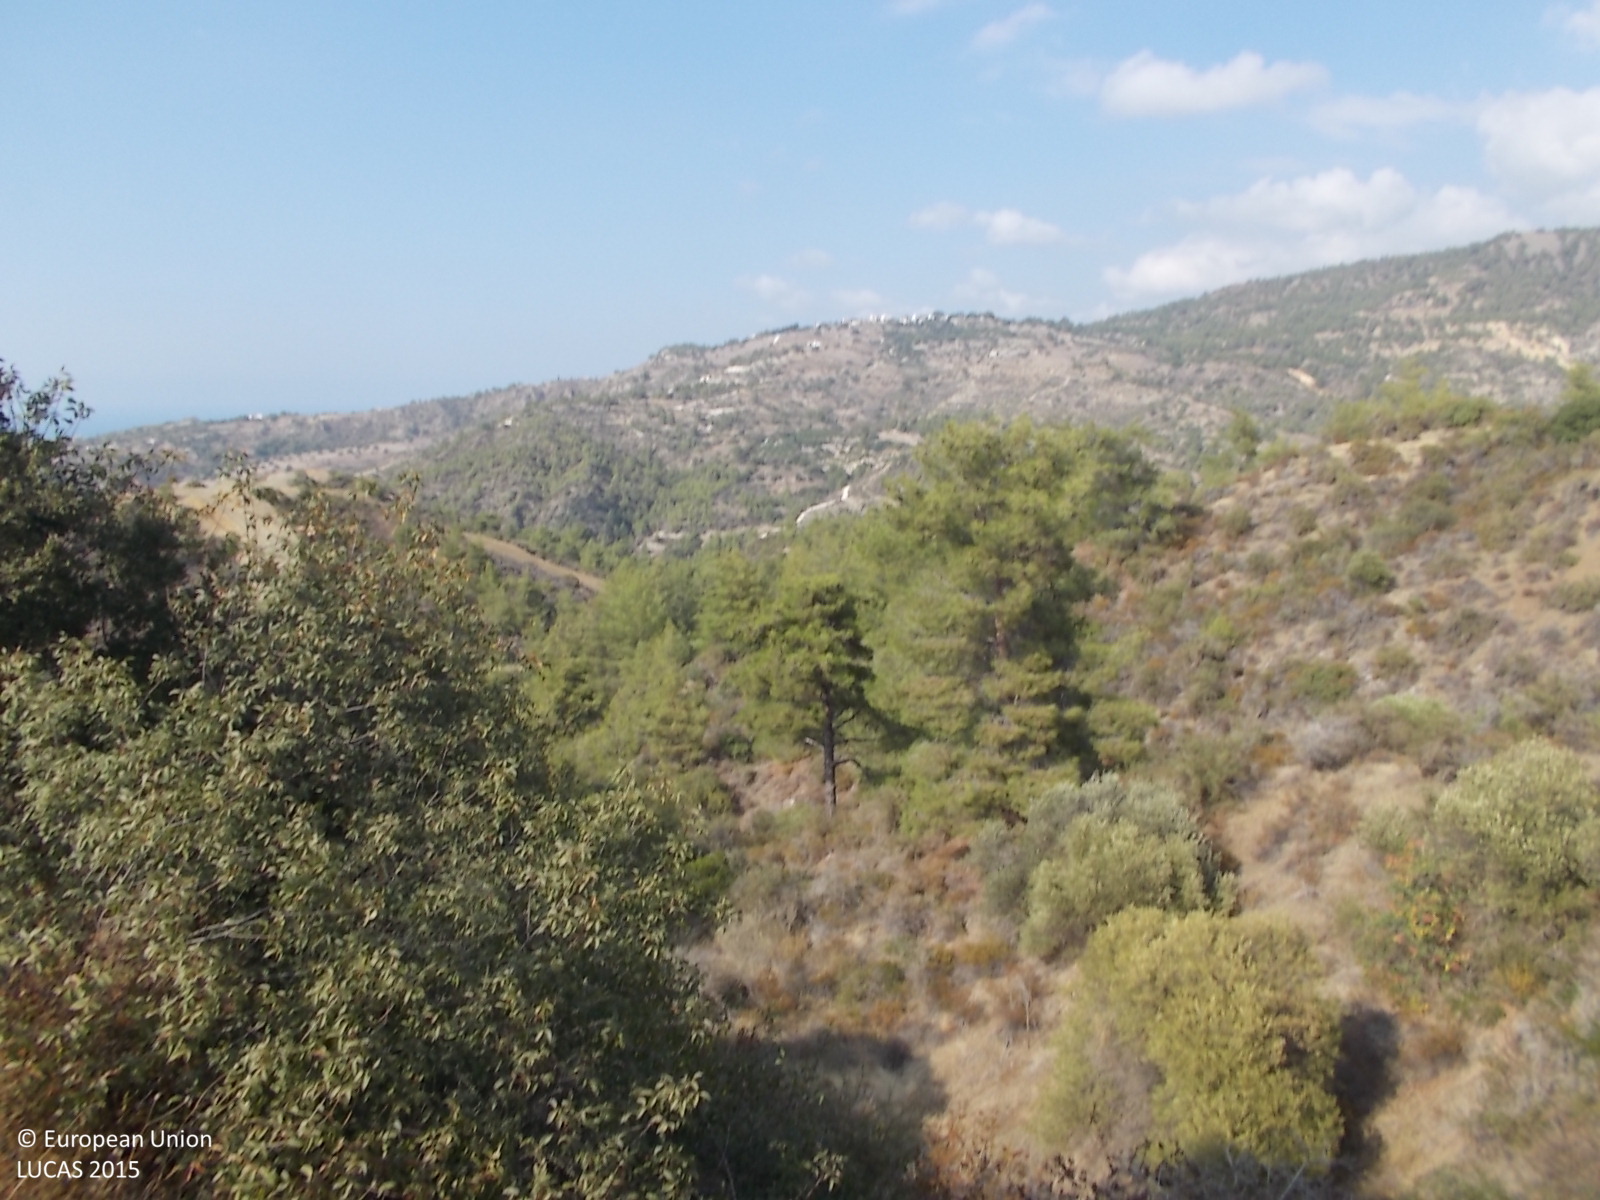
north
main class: Woodland
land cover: Pine dominated mixed woodland
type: coniferous forest of the mediterranean region
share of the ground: 25 - 50 %
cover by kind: coniferous forest trees 25 %, herbaceous plants 25 %, shrubs 20 %, broadleaved forest trees 15 %, unconsolidated bare surface 15 %
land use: Semi-natural and natural areas not in use
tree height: > 5 m
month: June
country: CY
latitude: 35.0140
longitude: 32.5000
